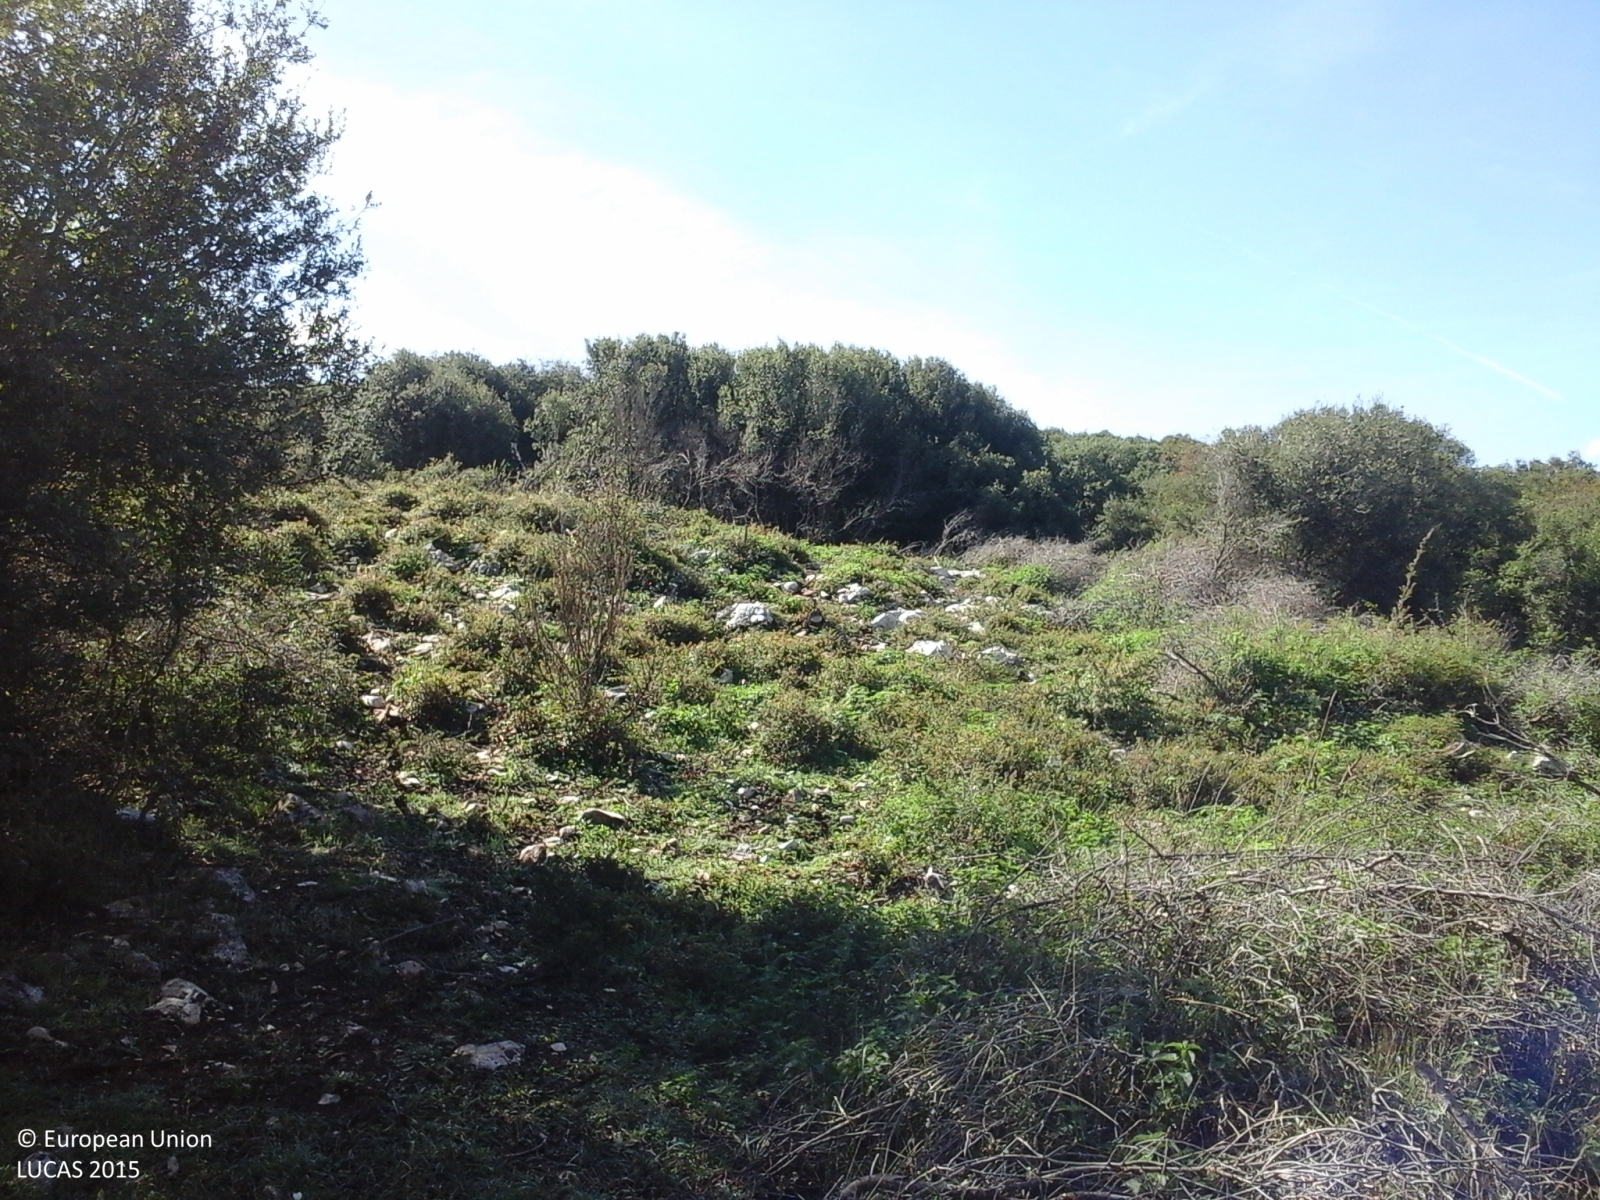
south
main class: Shrubland
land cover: Shrubland without tree cover
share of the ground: 50 - 75 %
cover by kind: shrubs 60 %, herbaceous plants 30 %, unconsolidated bare surface 10 %
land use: Agriculture (excluding fallow land and kitchen gardens)
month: October
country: GR
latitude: 39.5097
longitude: 20.9216
